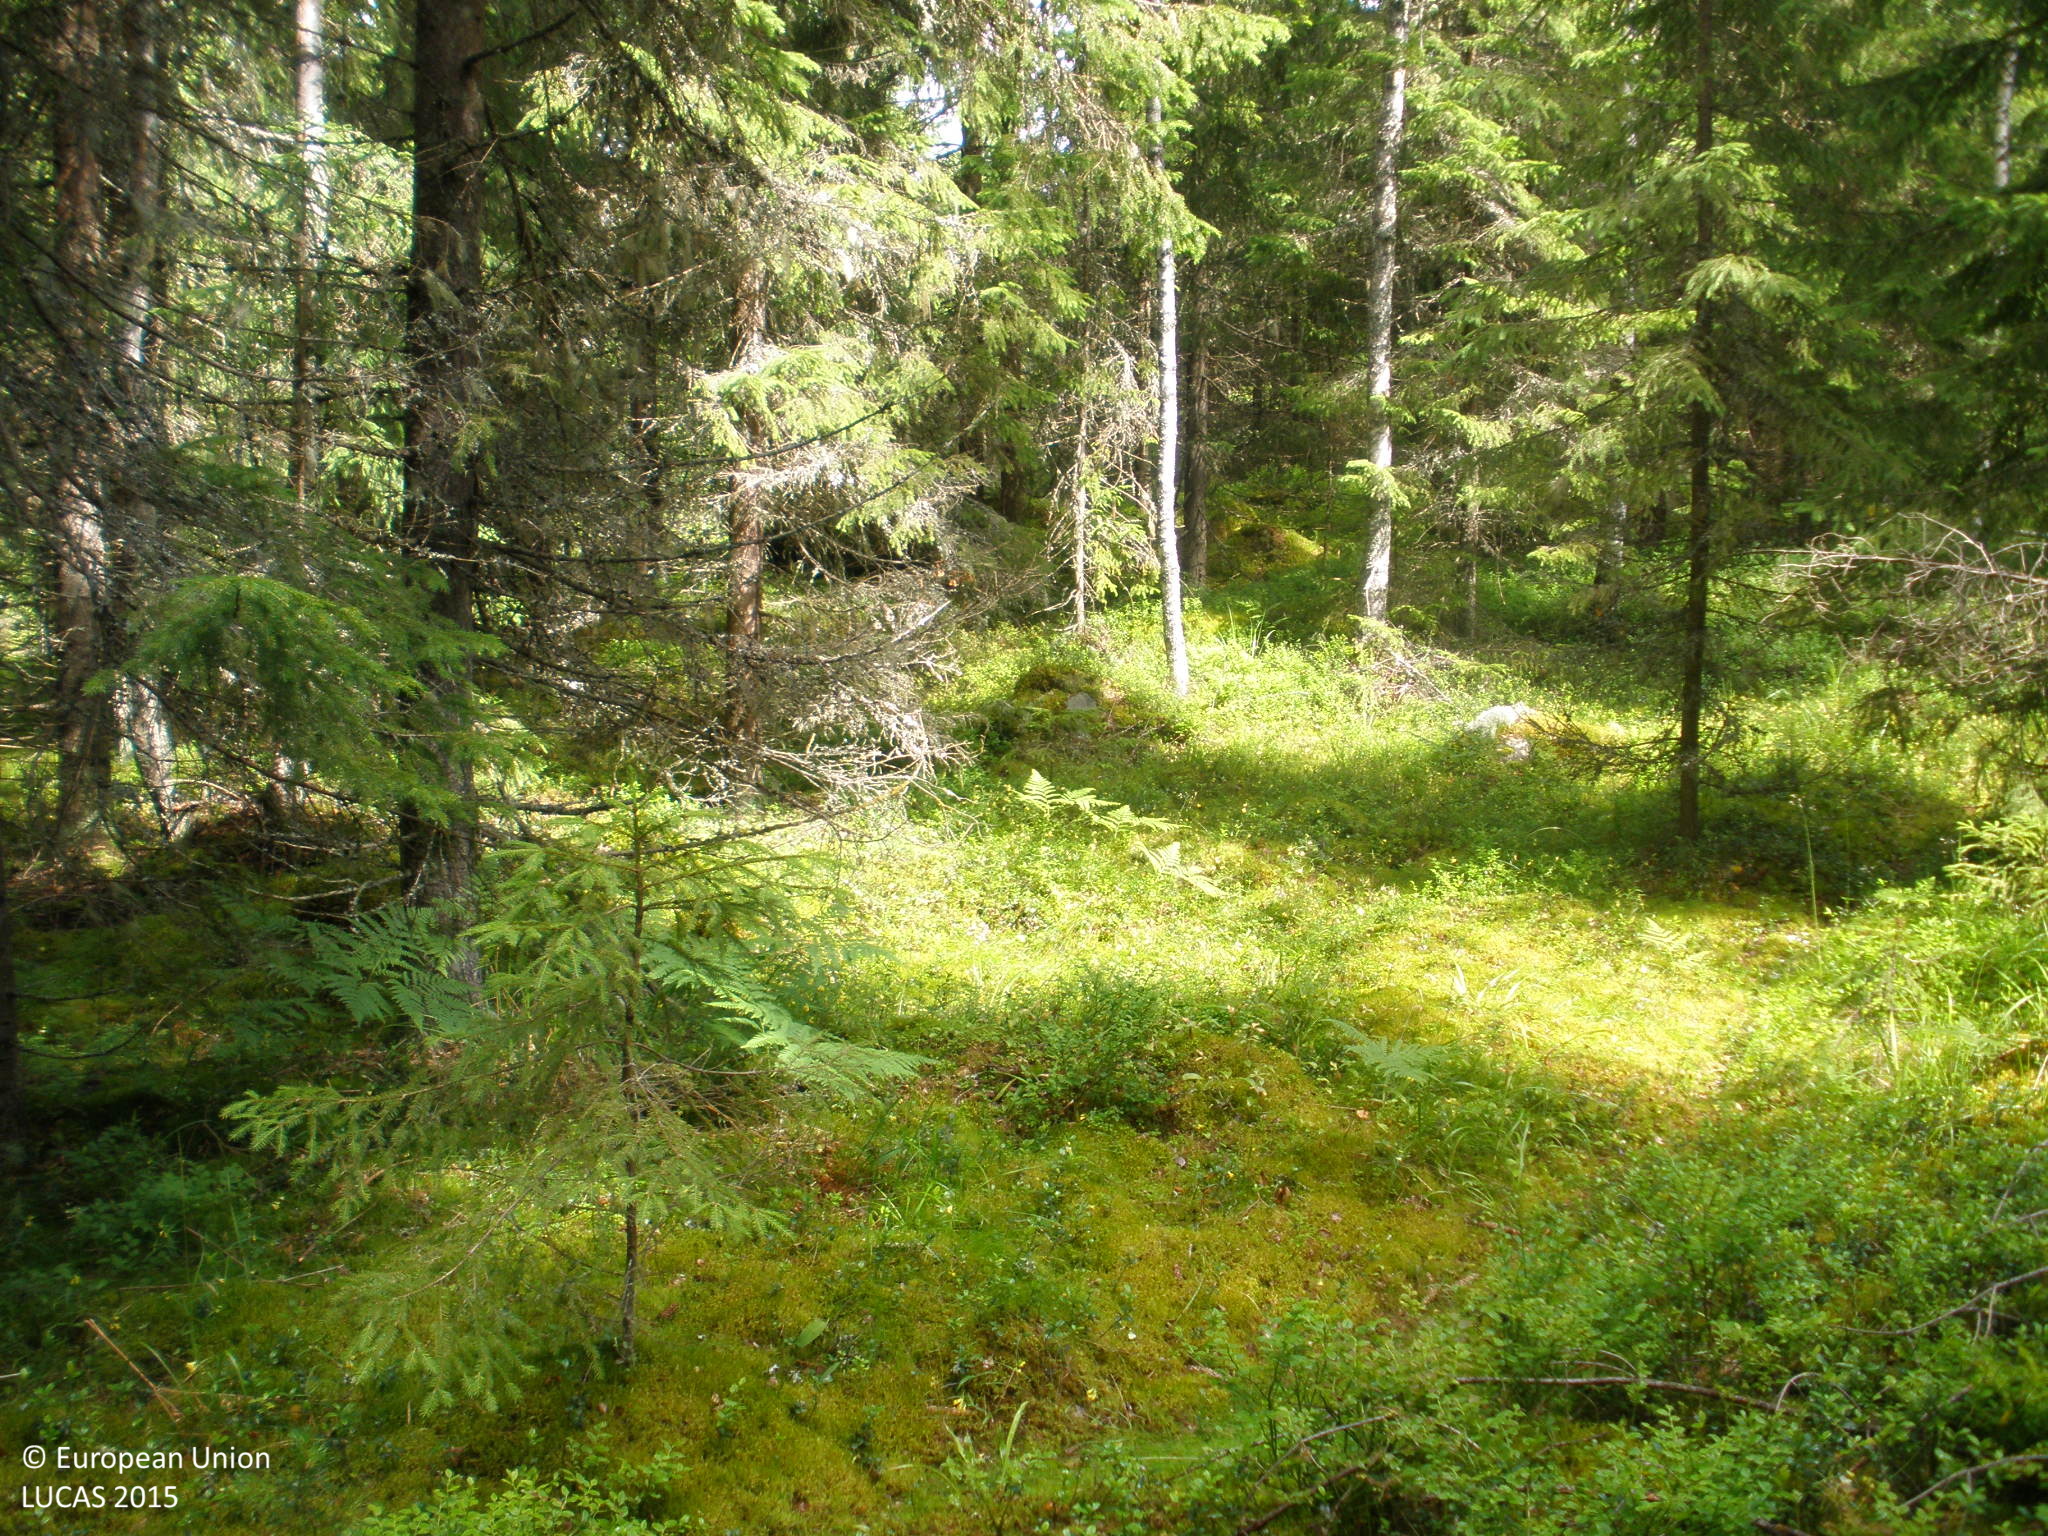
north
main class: Woodland
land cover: Spruce dominated coniferous woodland
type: boreal forest
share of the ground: > 75 %
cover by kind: coniferous forest trees 80 %, lichens and mosses 10 %, broadleaved forest trees 5 %, herbaceous plants 5 %
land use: Forestry
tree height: > 5 m
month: July
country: FI
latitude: 60.9902
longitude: 24.9940
